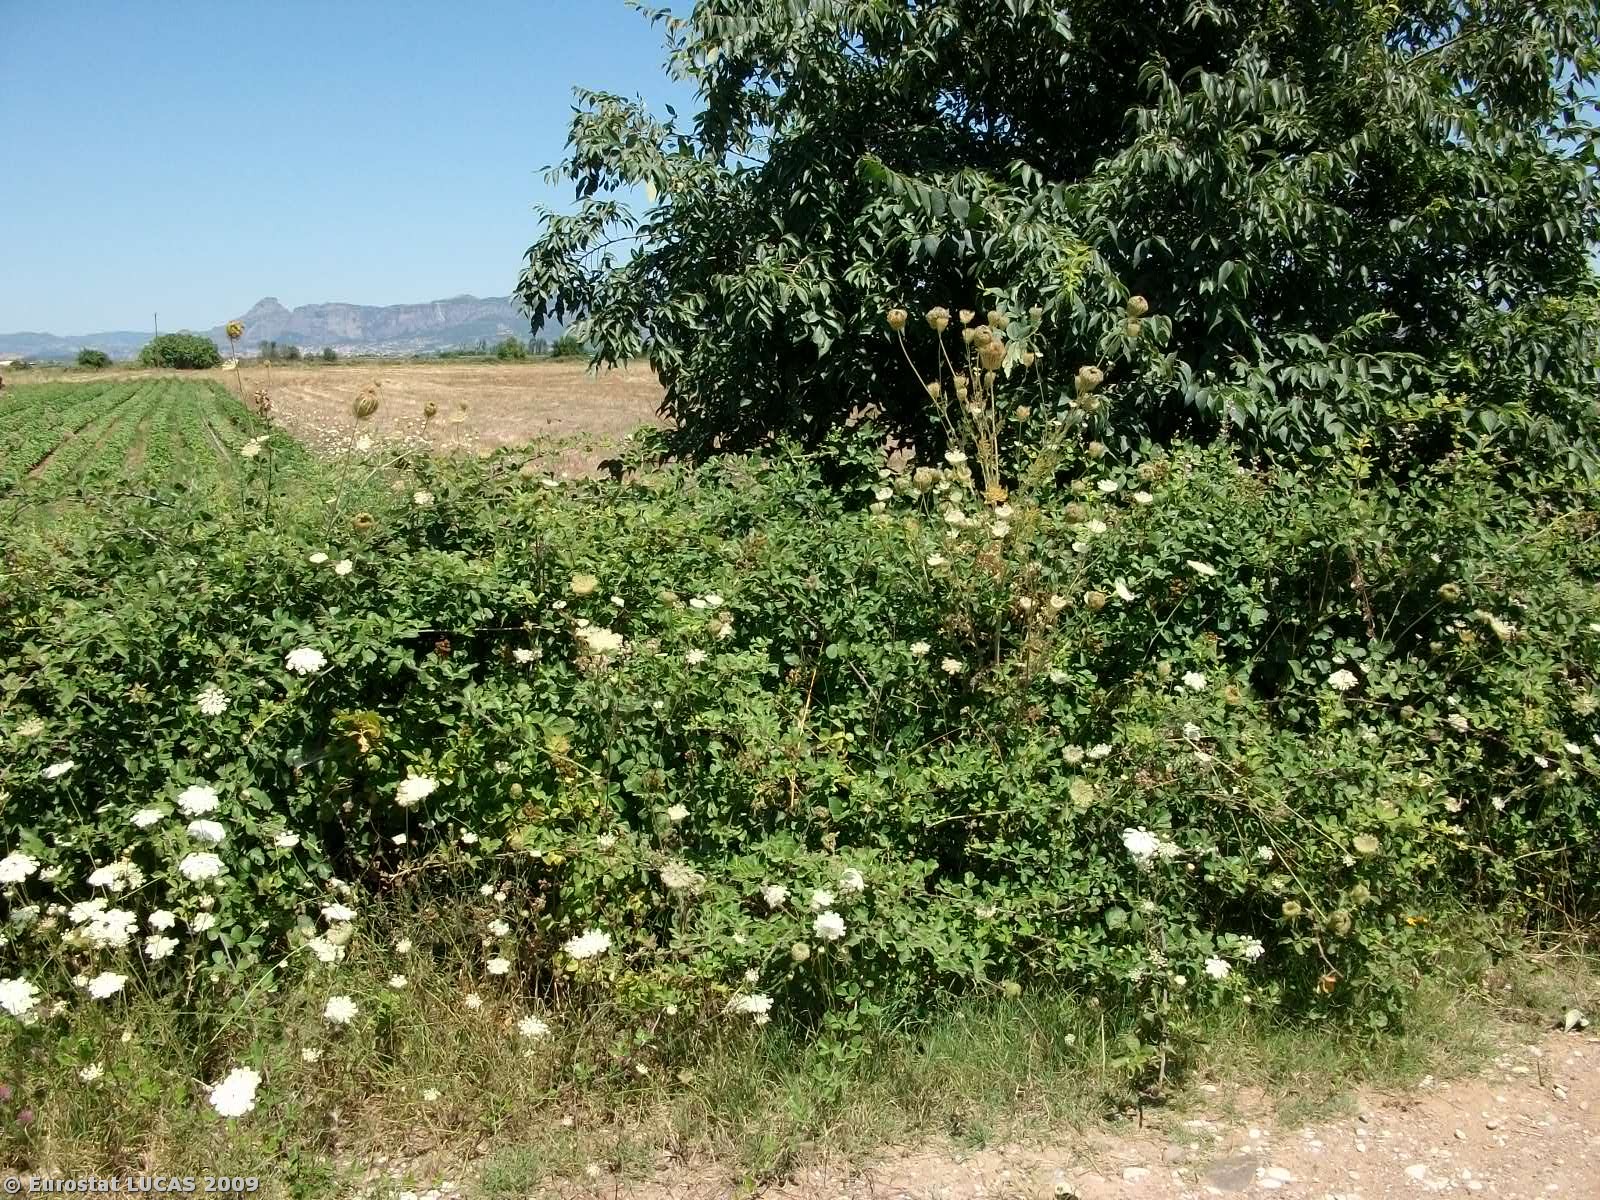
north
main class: Cropland
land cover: Maize
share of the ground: > 75 %
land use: Agriculture (excluding fallow land and kitchen gardens)
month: July
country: GR
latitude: 39.6234
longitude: 21.6679
